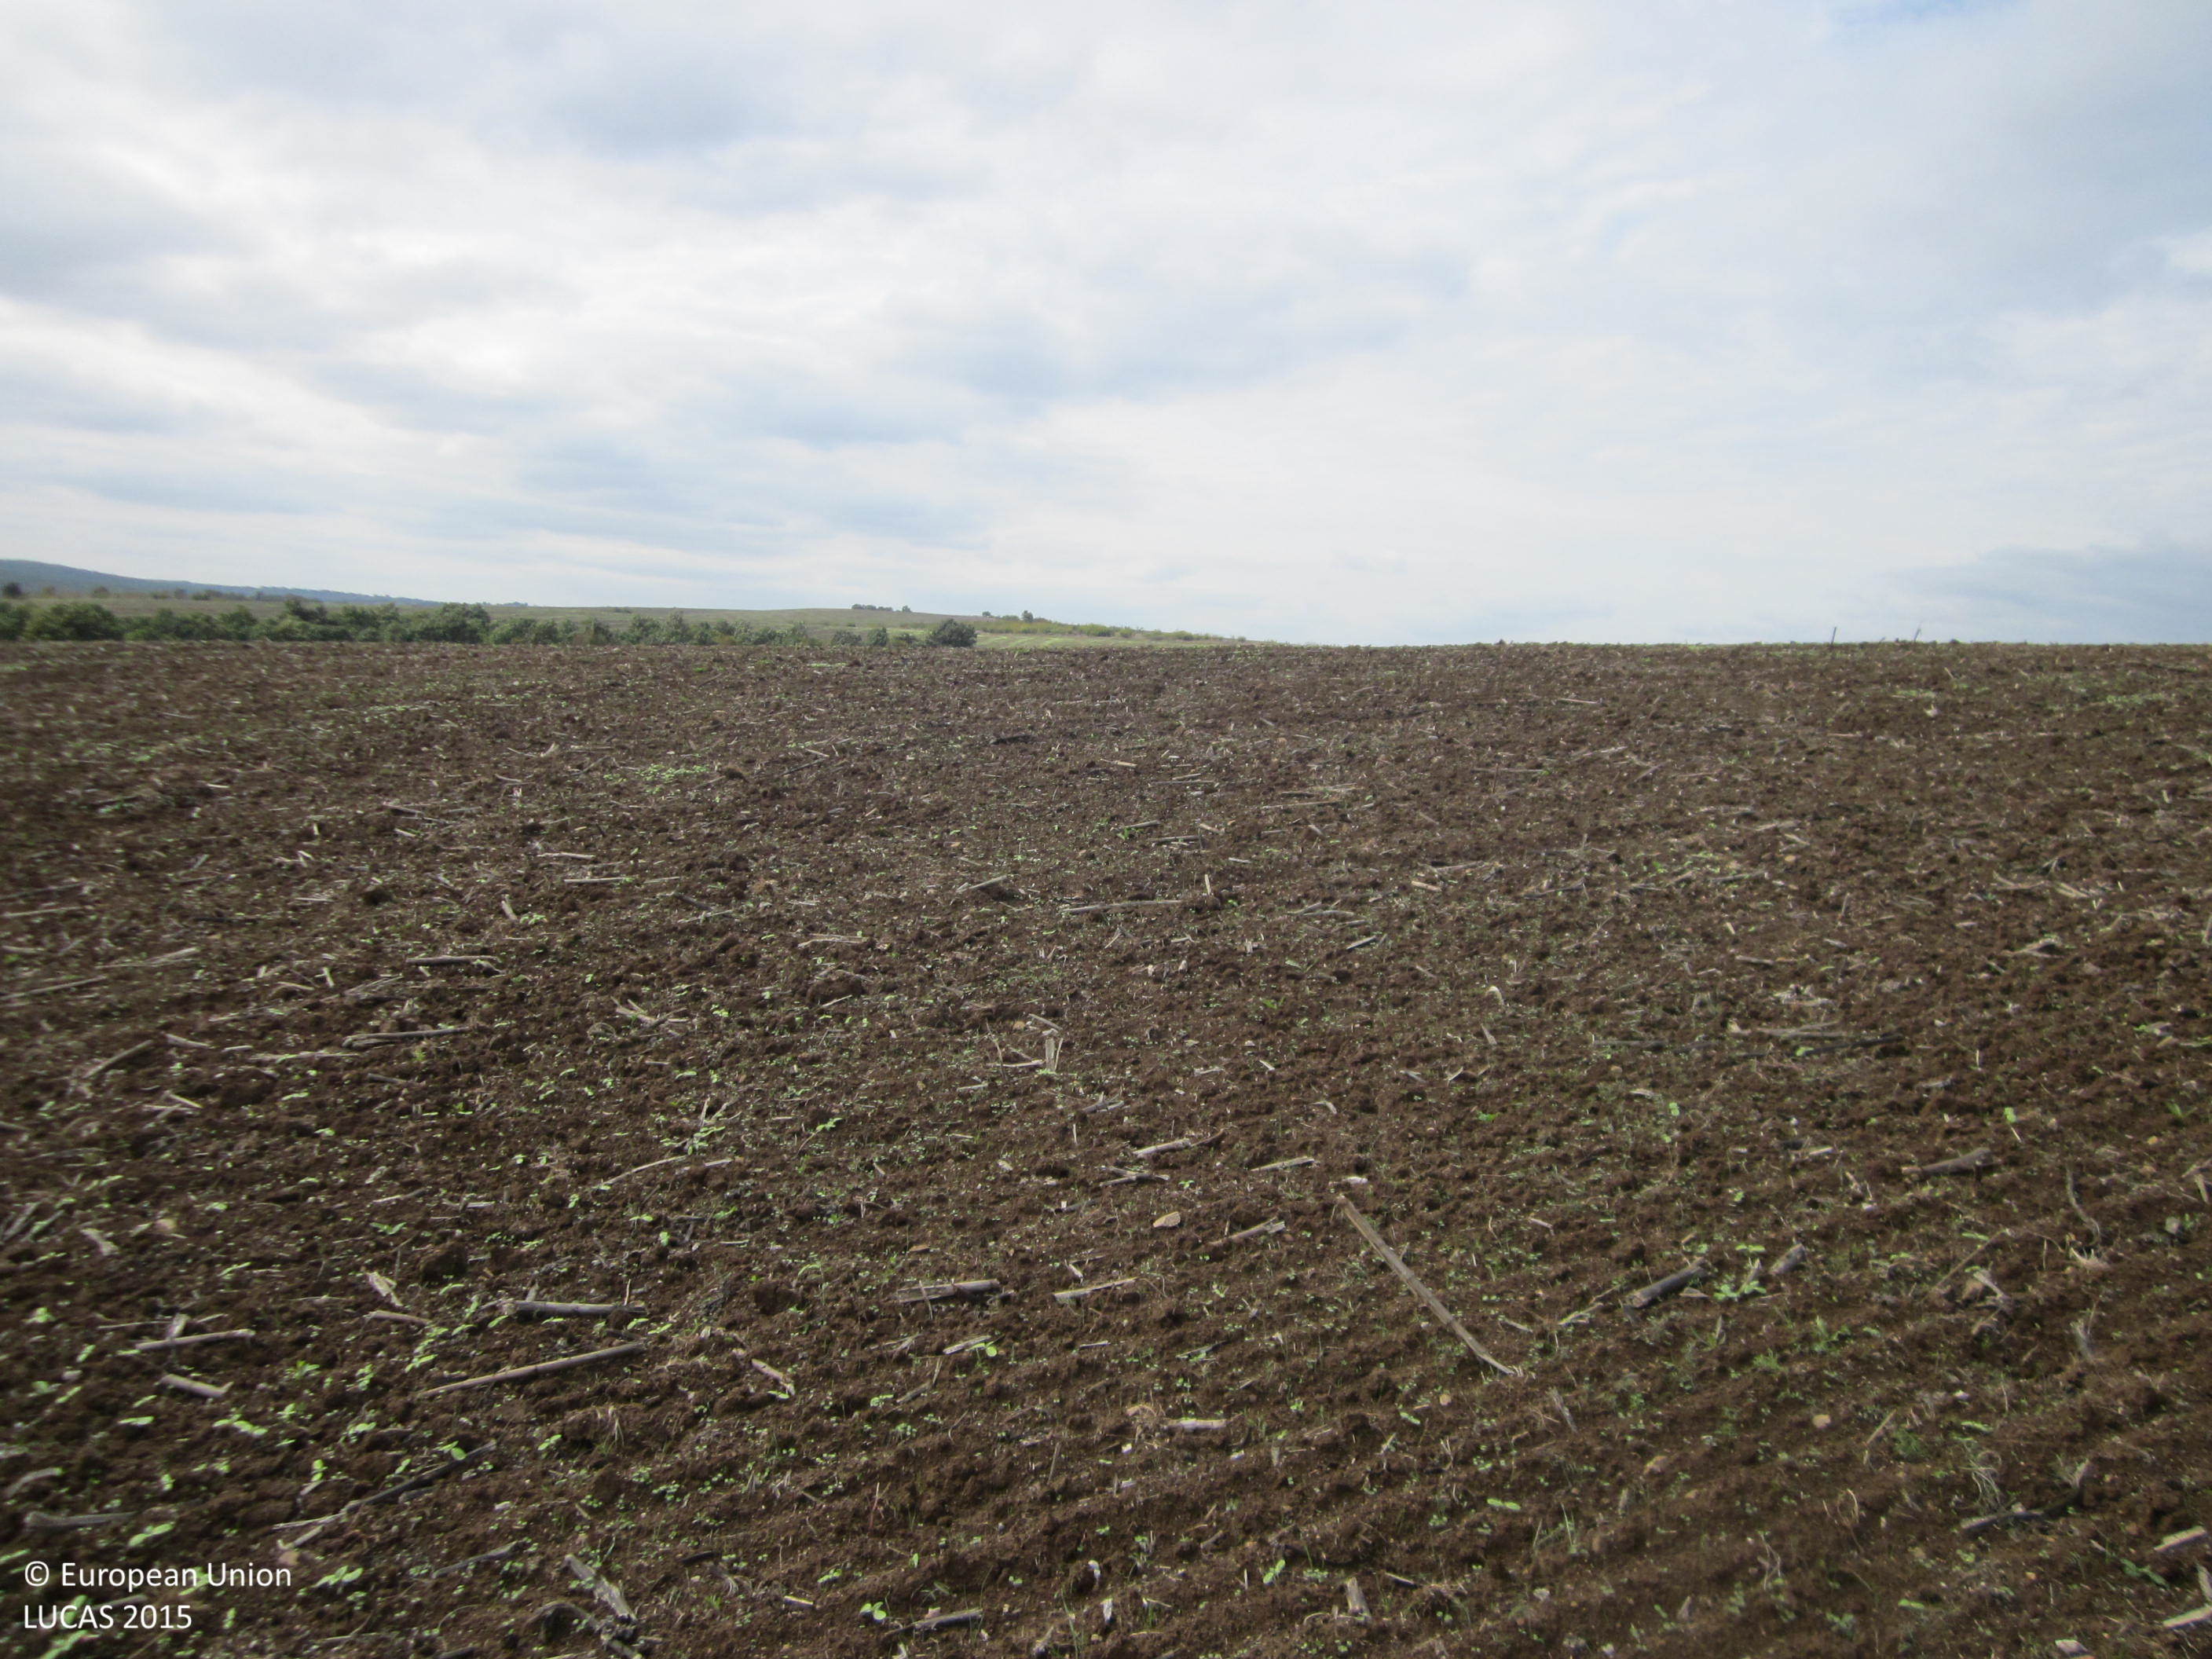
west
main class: Cropland
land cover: Sunflower
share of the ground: < 10 %
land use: Agriculture (excluding fallow land and kitchen gardens)
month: October
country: BG
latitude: 42.3658
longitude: 26.9930
